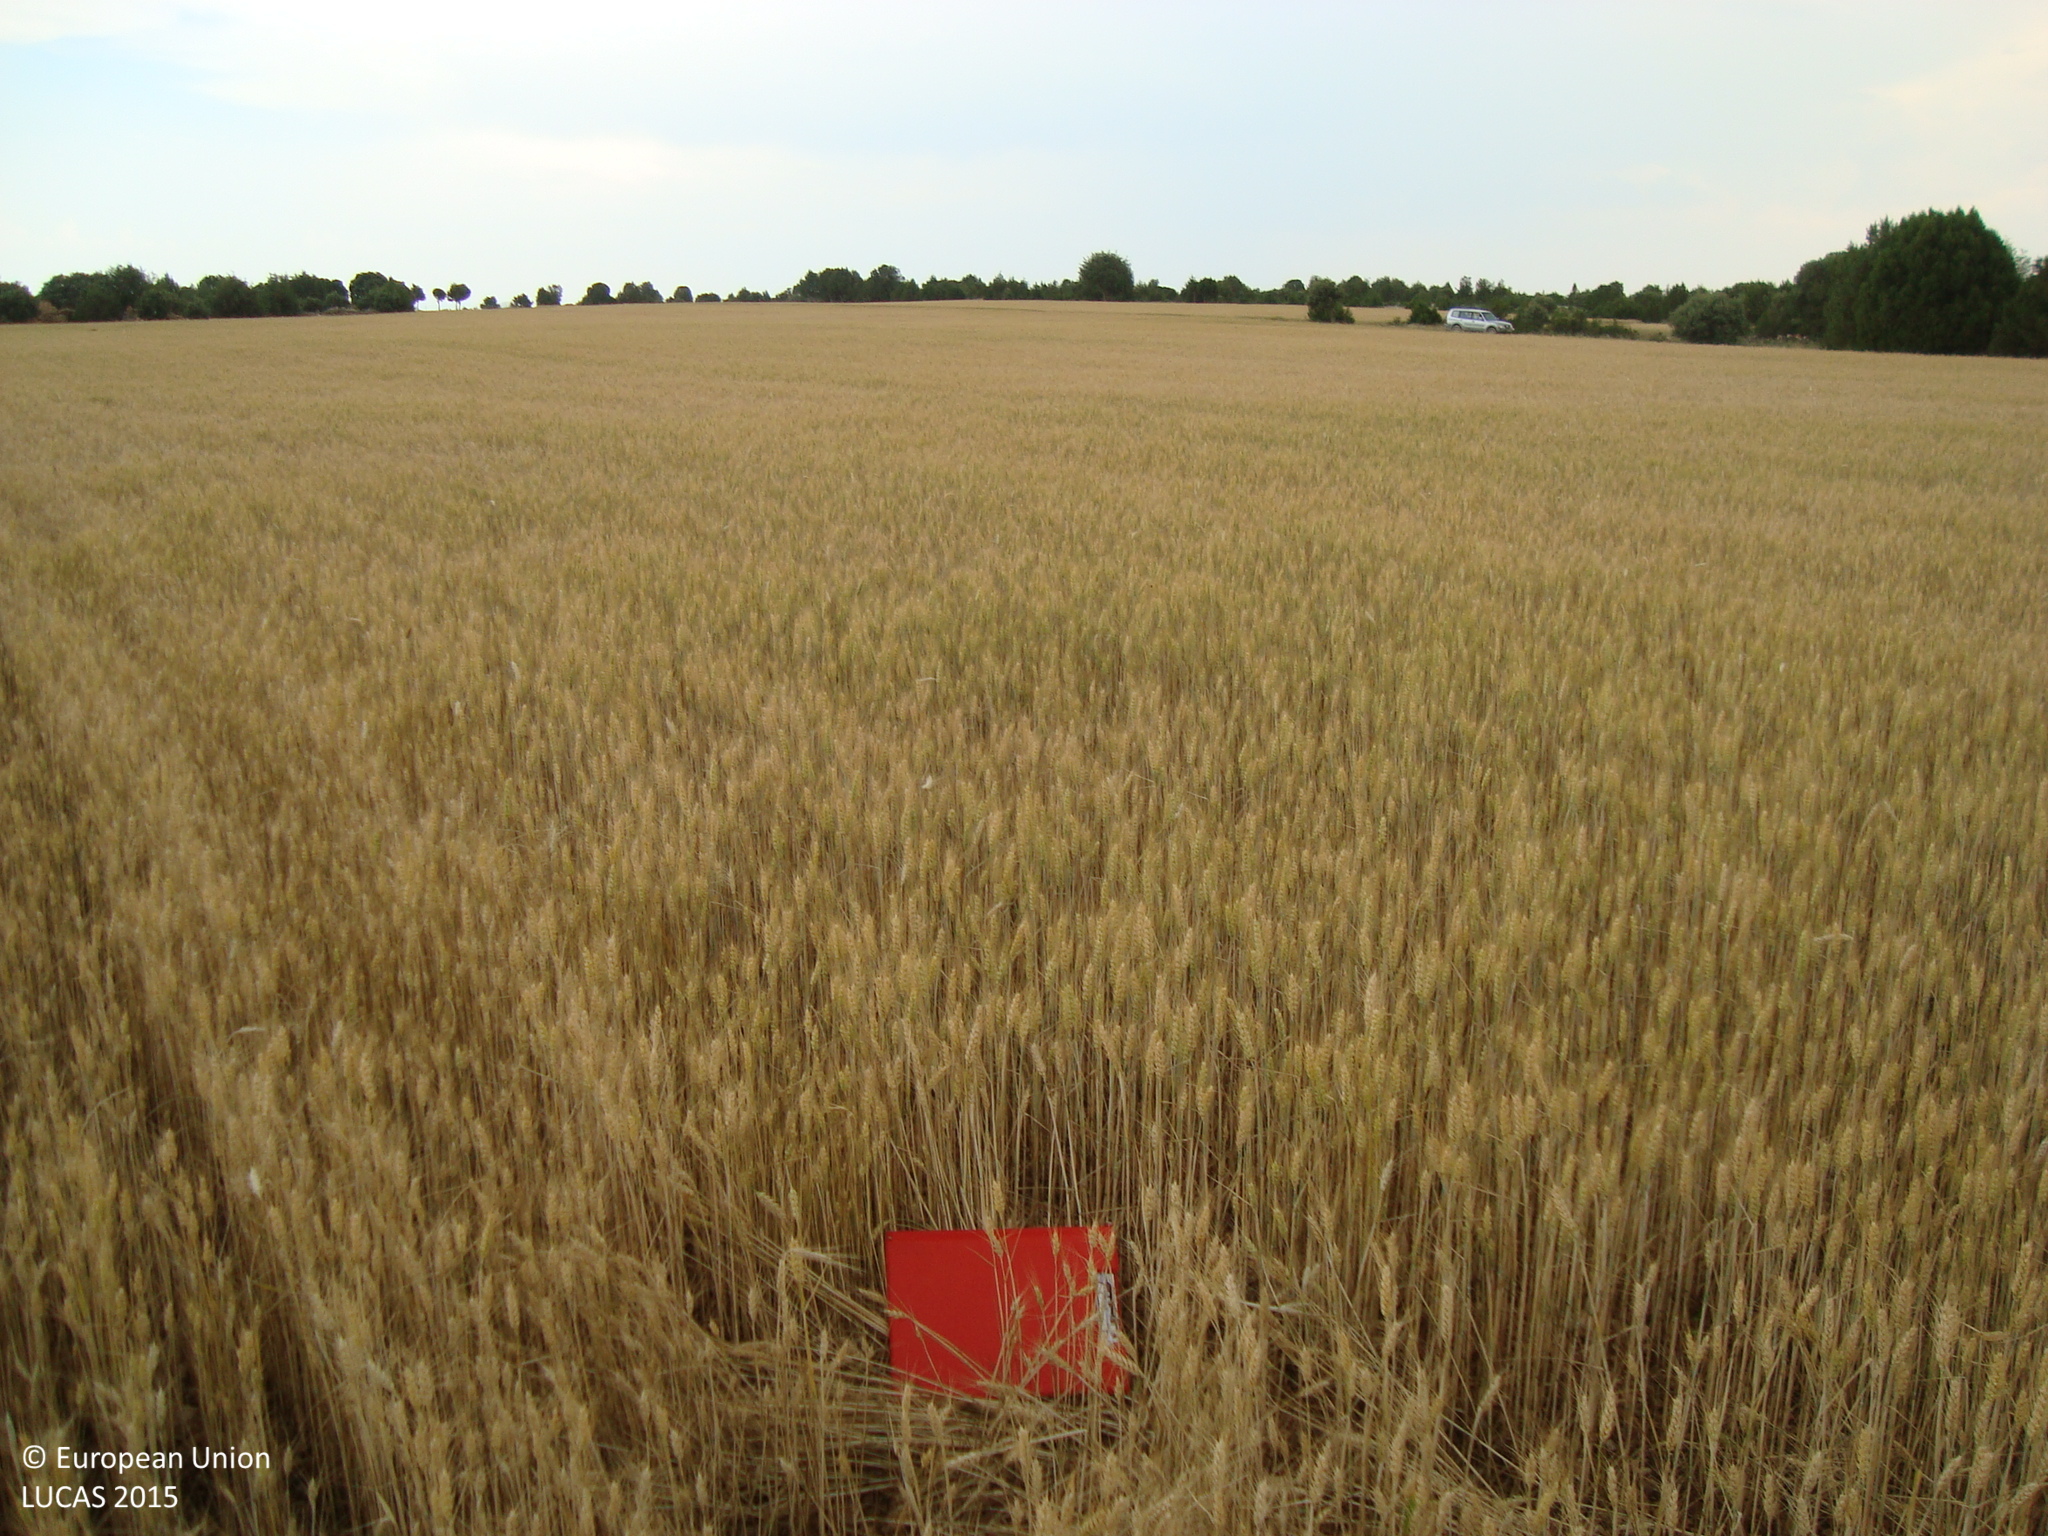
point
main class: Cropland
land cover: Common wheat
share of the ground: > 75 %
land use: Agriculture (excluding fallow land and kitchen gardens)
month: June
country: ES
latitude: 41.9269
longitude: -3.6456
